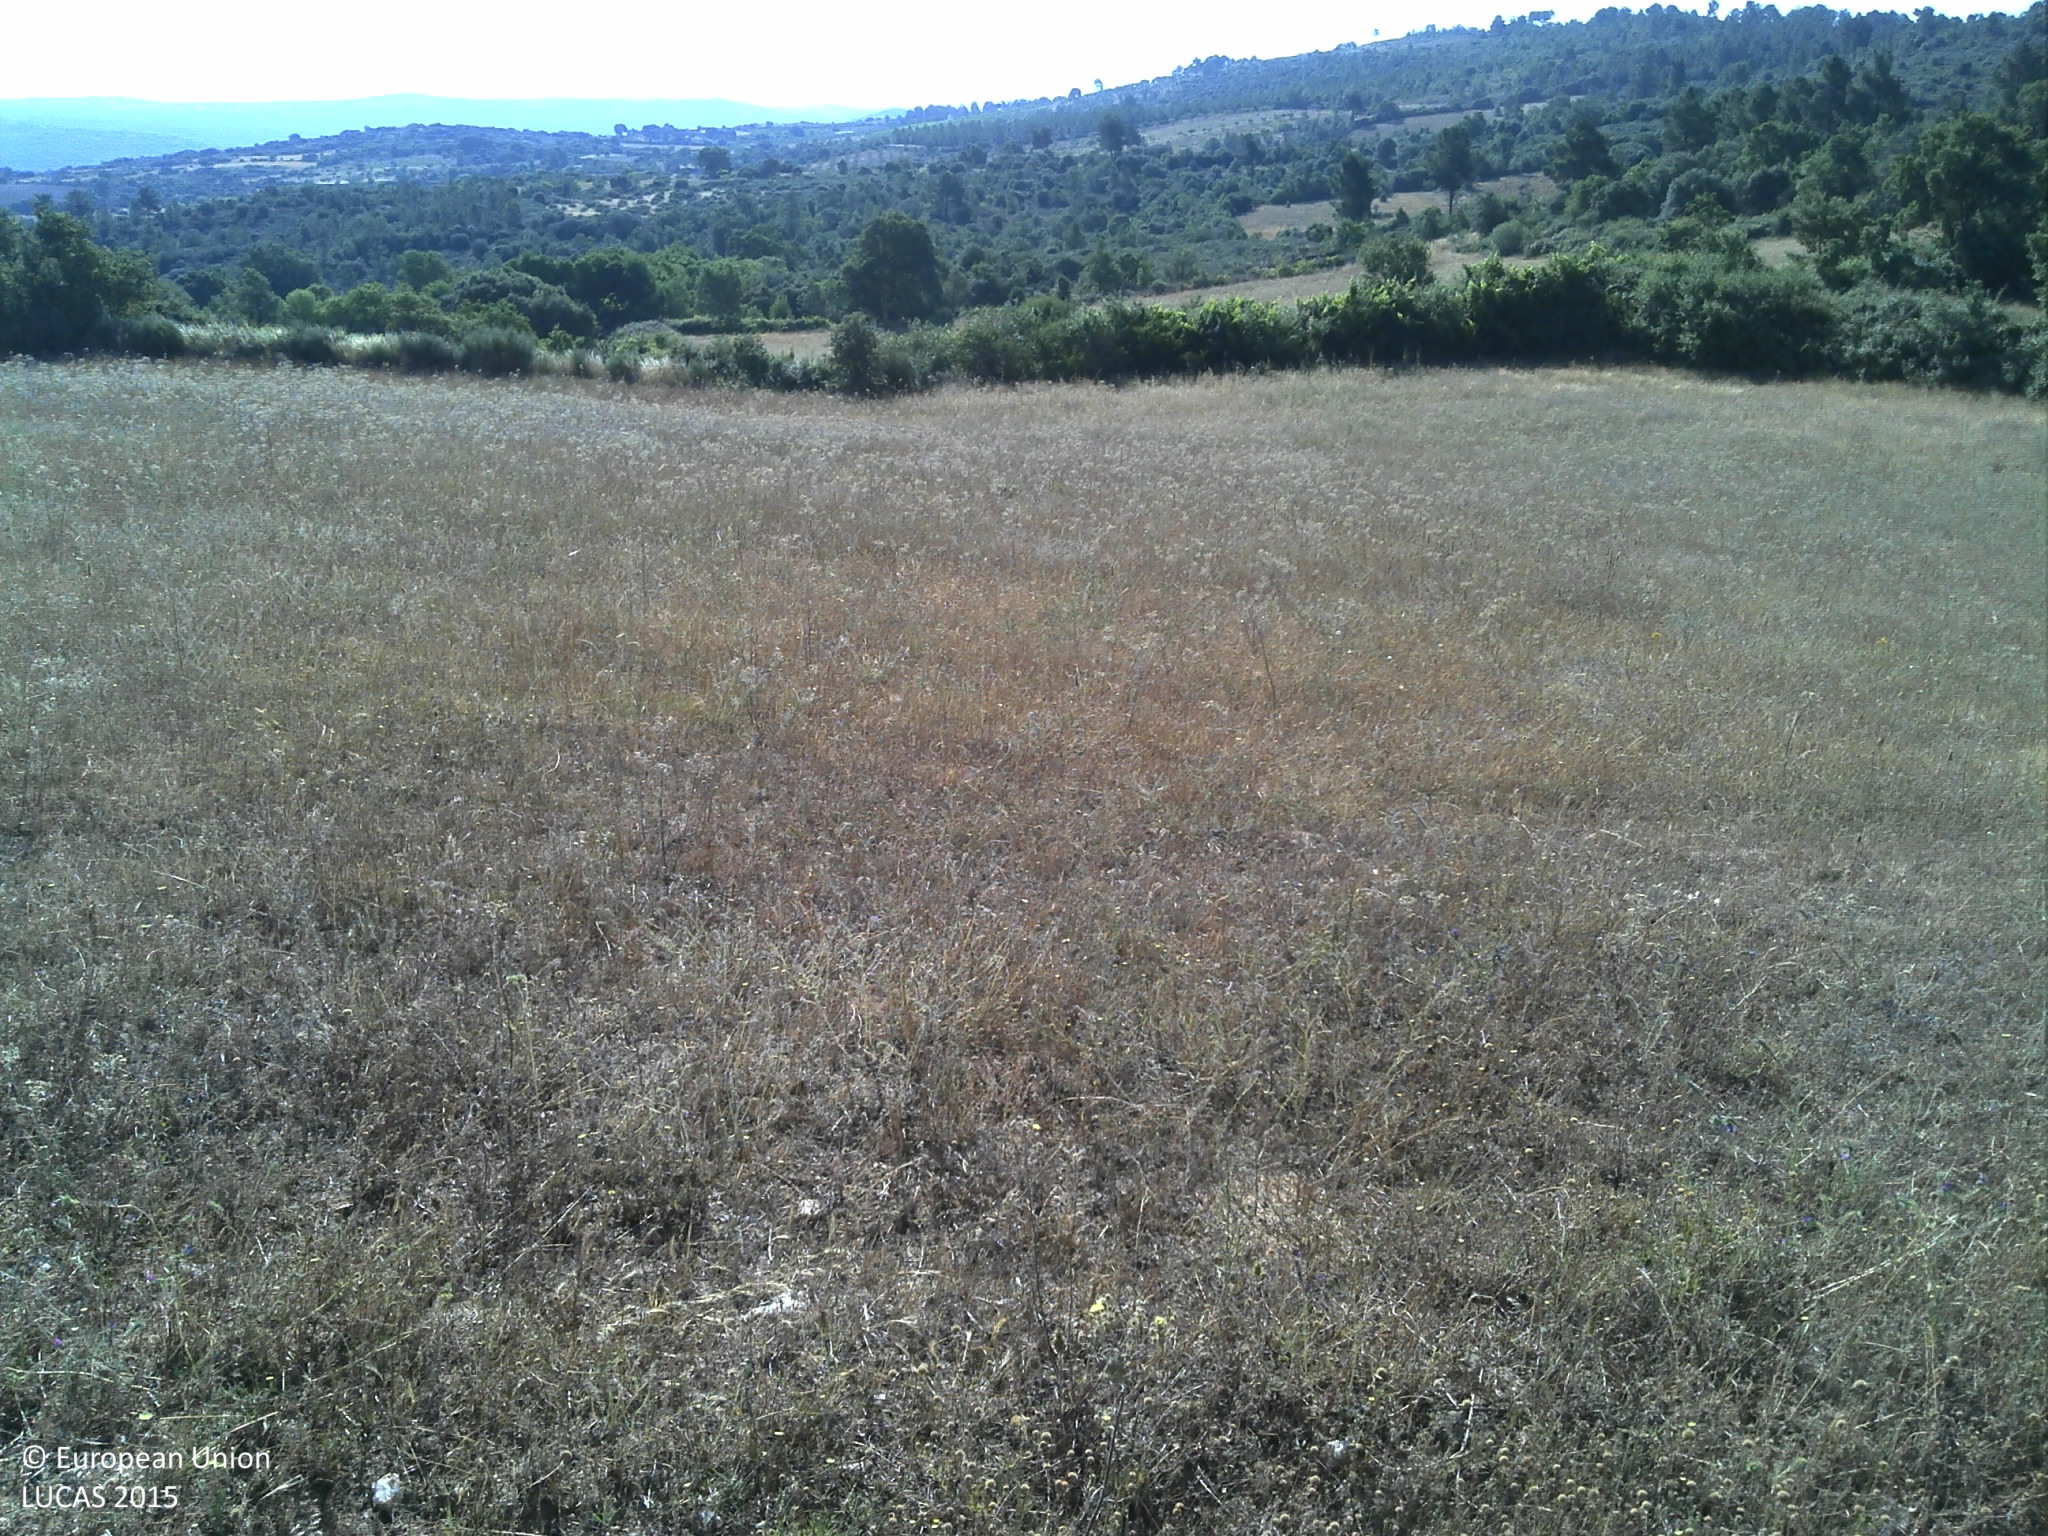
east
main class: Grassland
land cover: Spontaneously vegetated surfaces
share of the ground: > 75 %
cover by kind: herbaceous plants 95 %, unconsolidated bare surface 5 %
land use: Fallow land
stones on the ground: 10 - 25 %
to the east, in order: Spontaneously vegetated surfaces; Abandoned hedges; Dry stone walls; Shrubland with sparse tree cover; Spontaneously vegetated surfaces; Shruby margins; Tracks; Dry stone walls; Broadleaved woodland
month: June
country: PT
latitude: 40.8772
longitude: -6.8692
